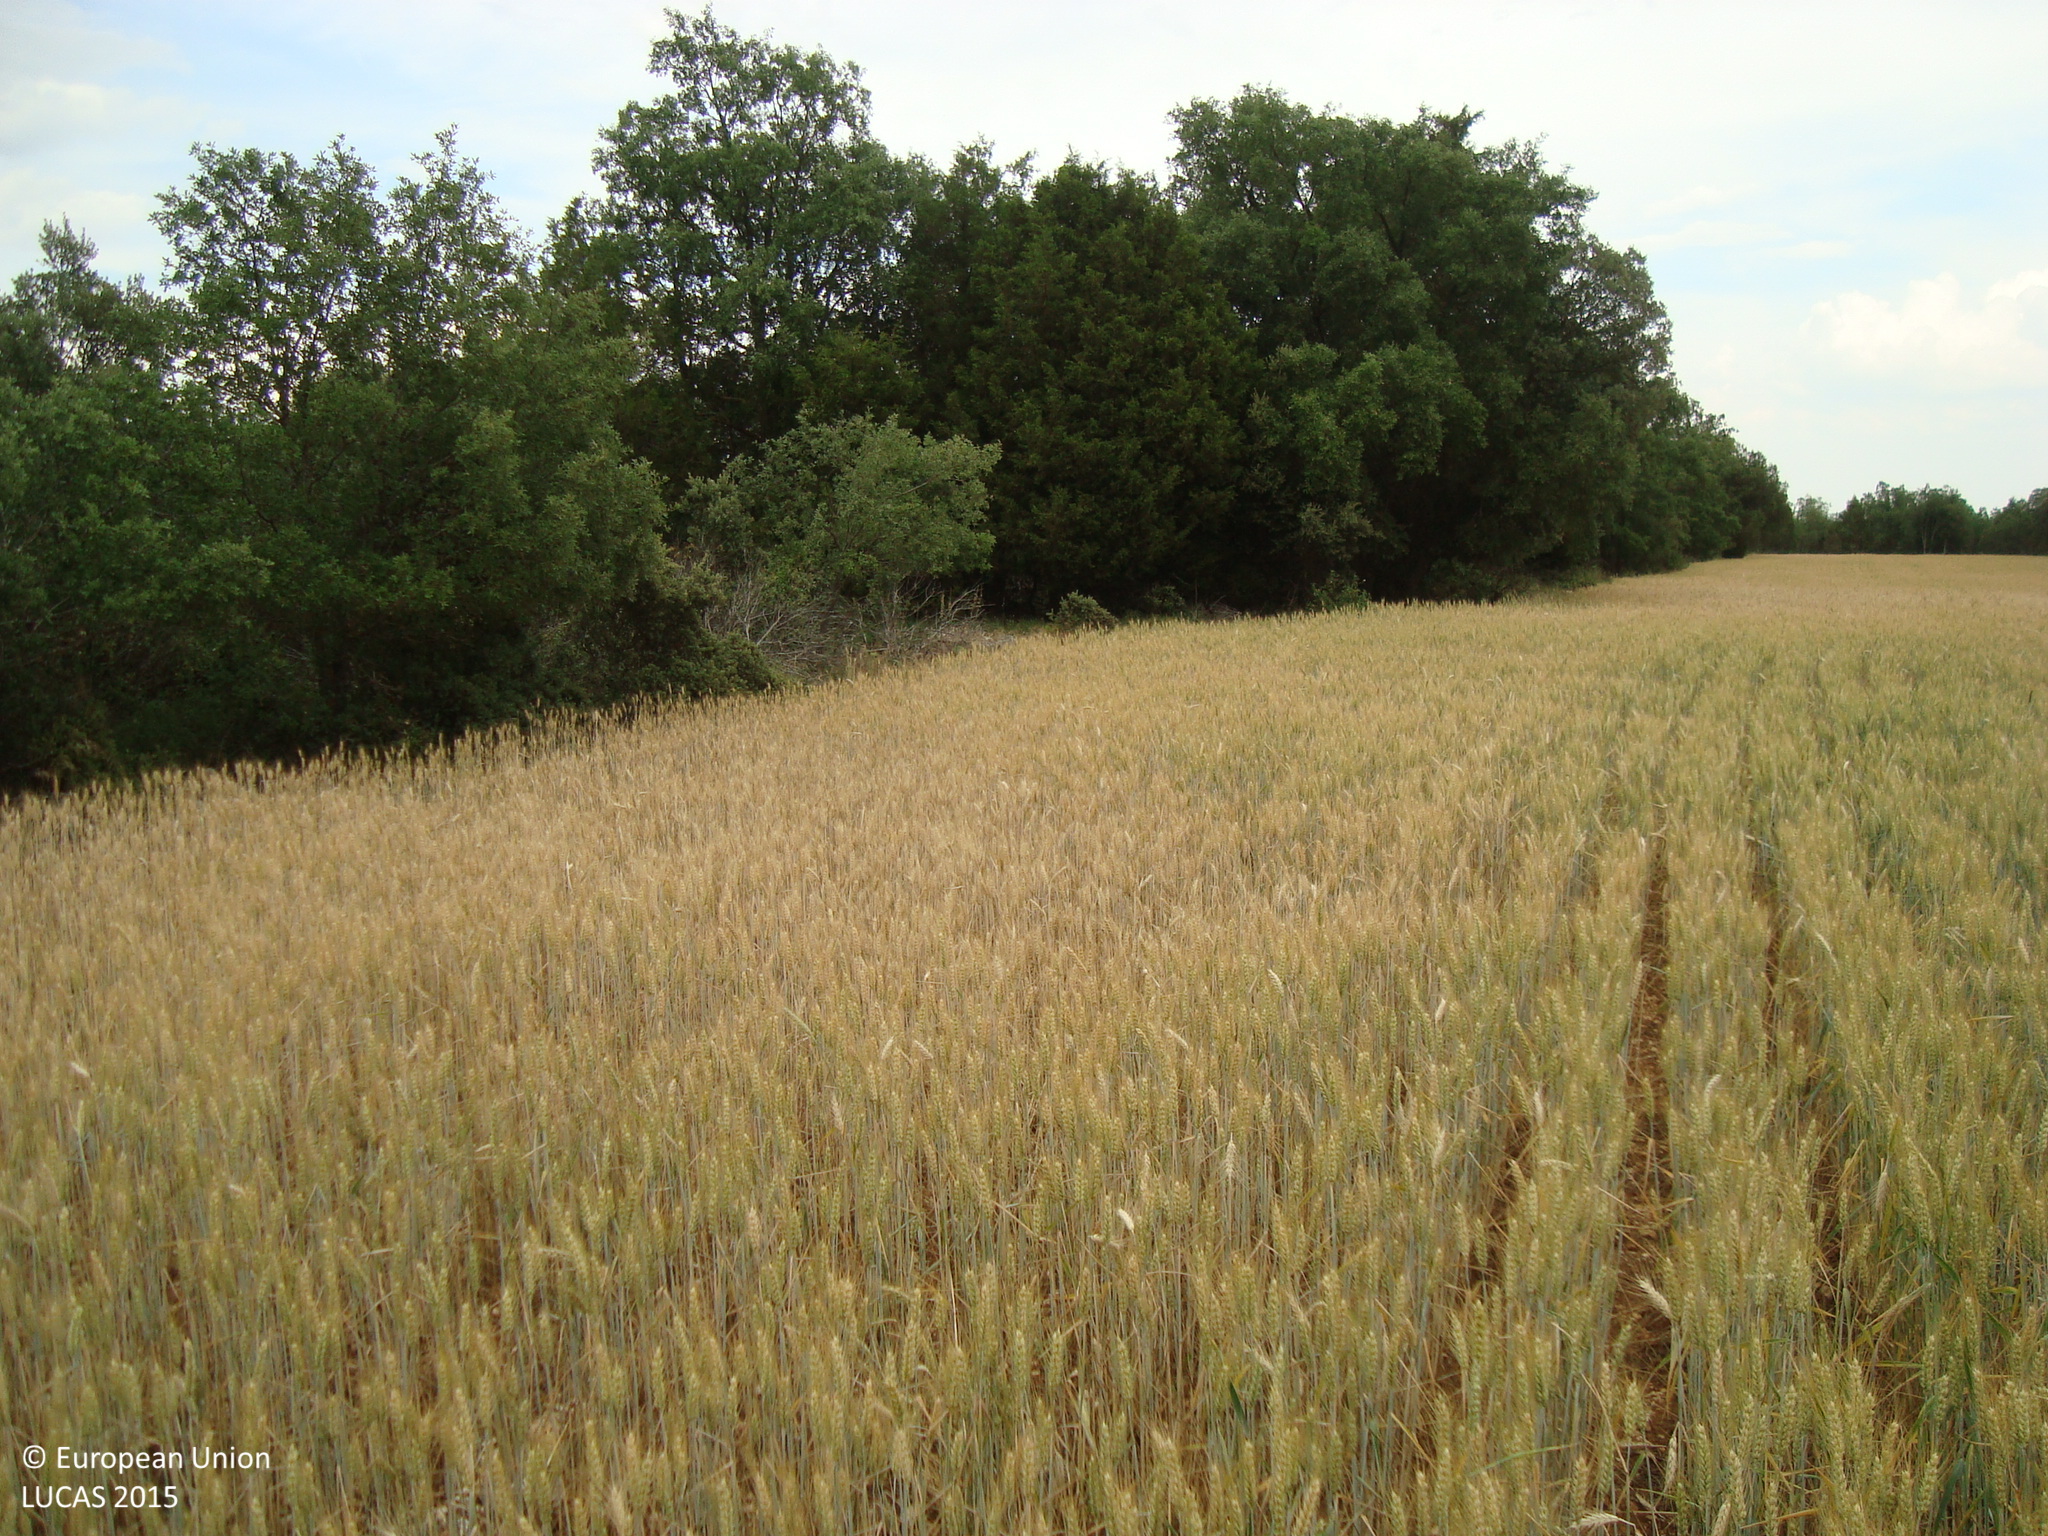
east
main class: Cropland
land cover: Common wheat
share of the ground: > 75 %
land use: Agriculture (excluding fallow land and kitchen gardens)
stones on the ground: < 10 %
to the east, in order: Common wheat; Broadleaved woodland
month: June
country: ES
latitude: 41.9381
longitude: -3.6971
